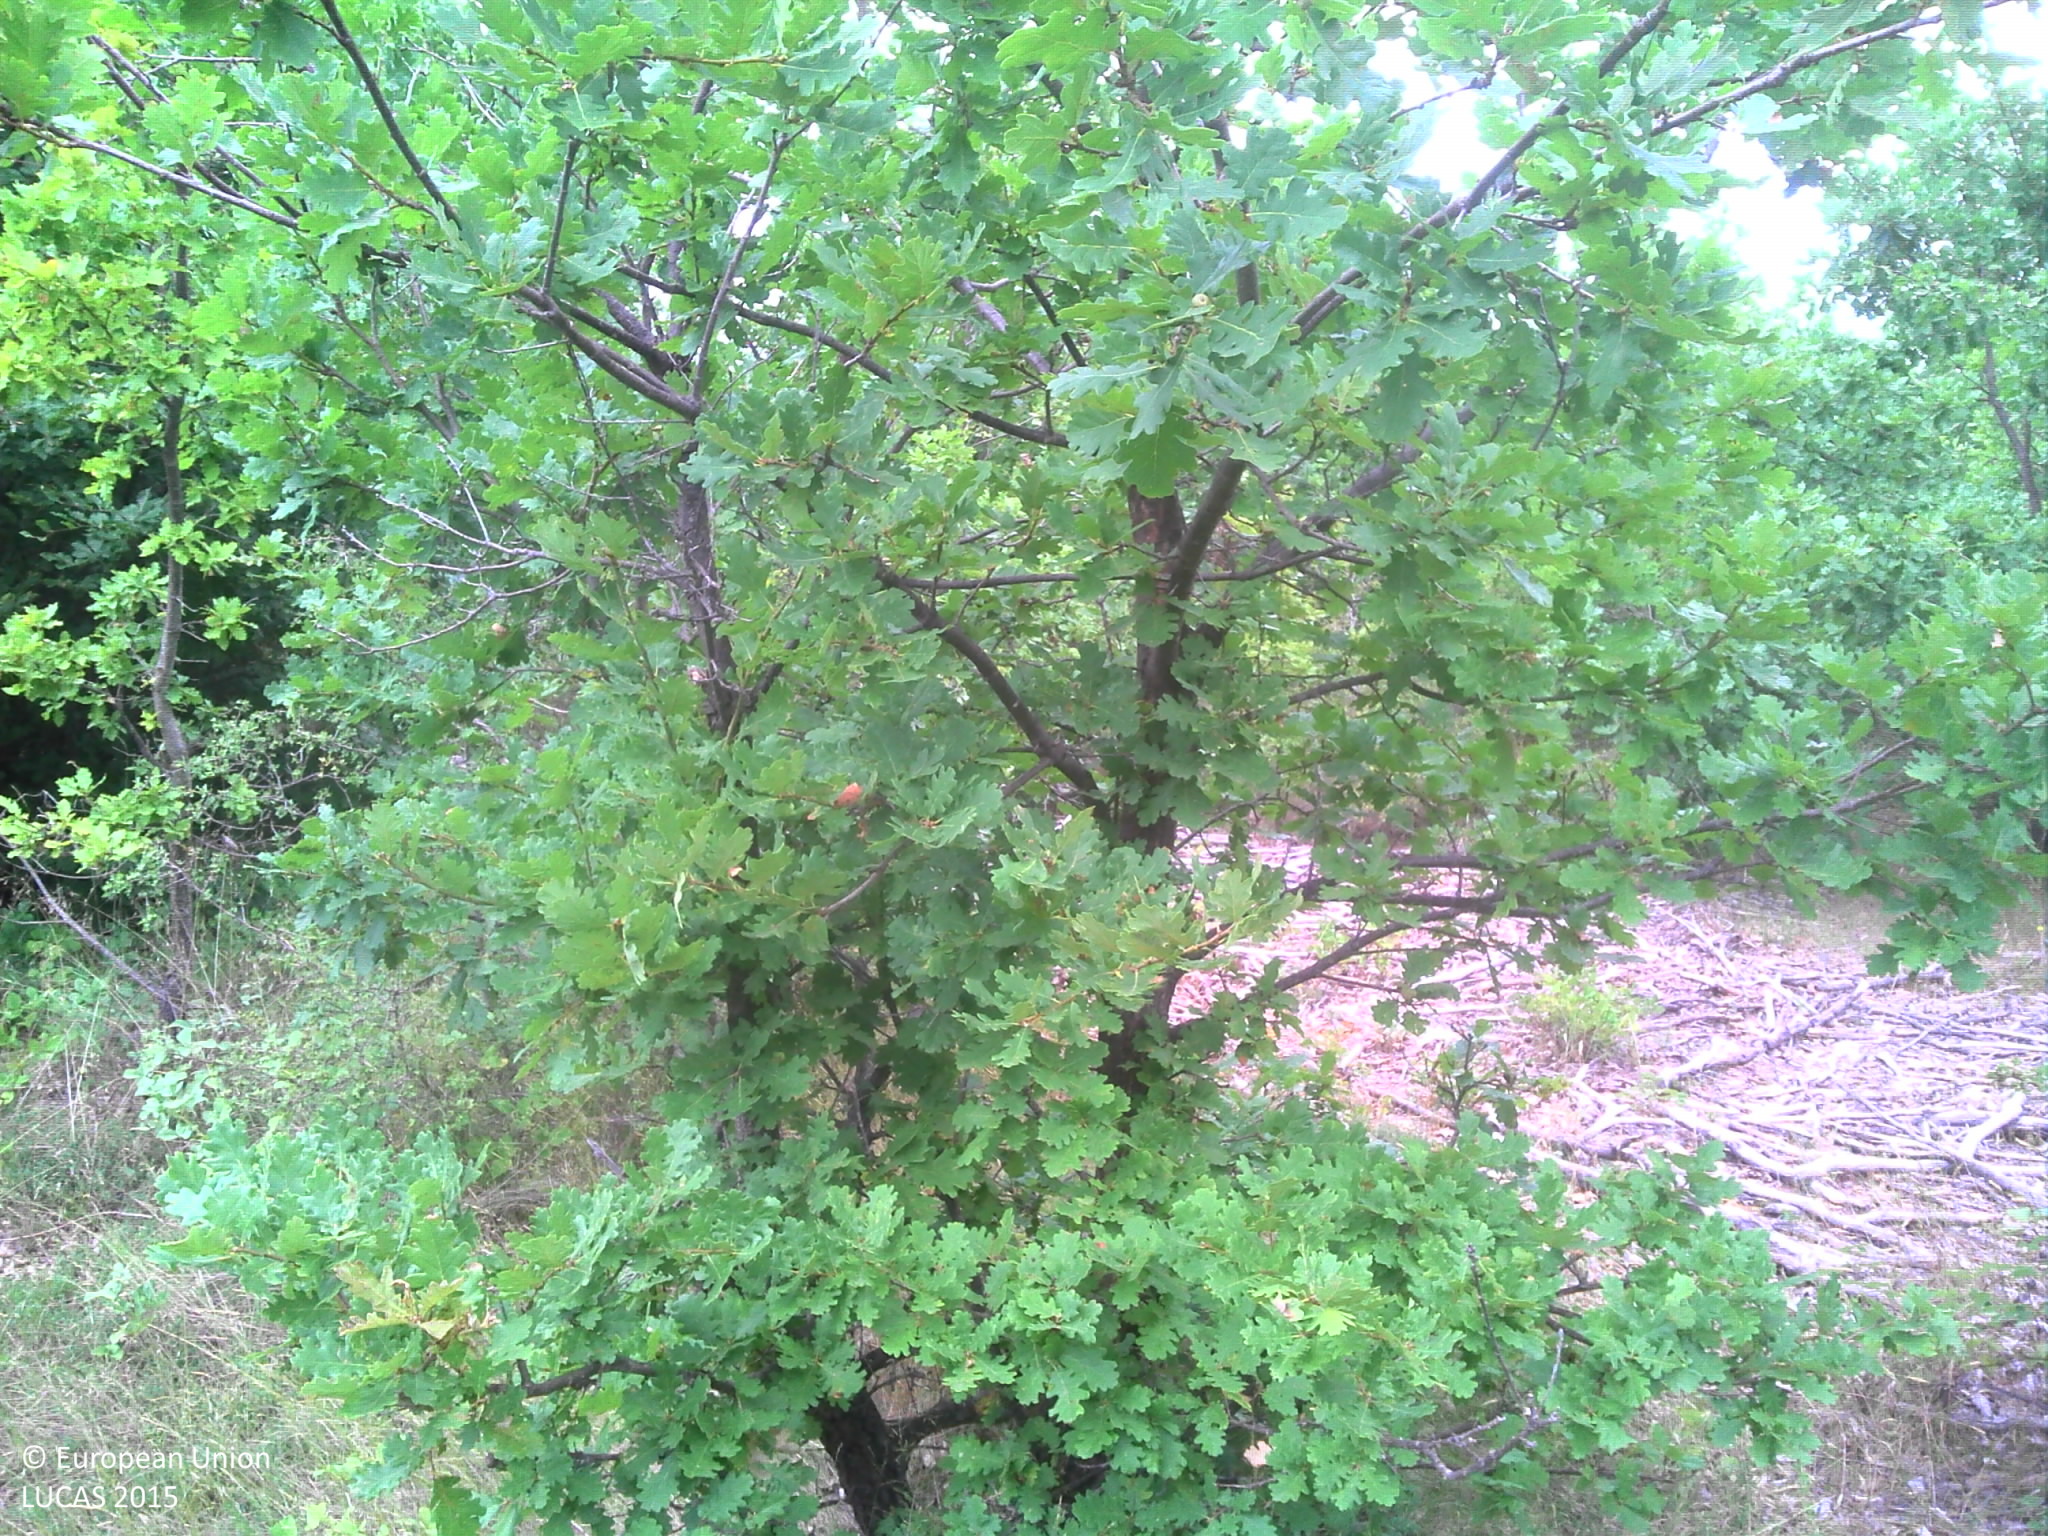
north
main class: Woodland
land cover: Broadleaved woodland
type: thermophilous deciduous forest
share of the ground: 50 - 75 %
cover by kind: broadleaved forest trees 65 %, shrubs 20 %, herbaceous plants 10 %, consolidated bare surface 5 %
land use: Forestry
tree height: > 5 m
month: July
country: FR
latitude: 44.0576
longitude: 5.5767
